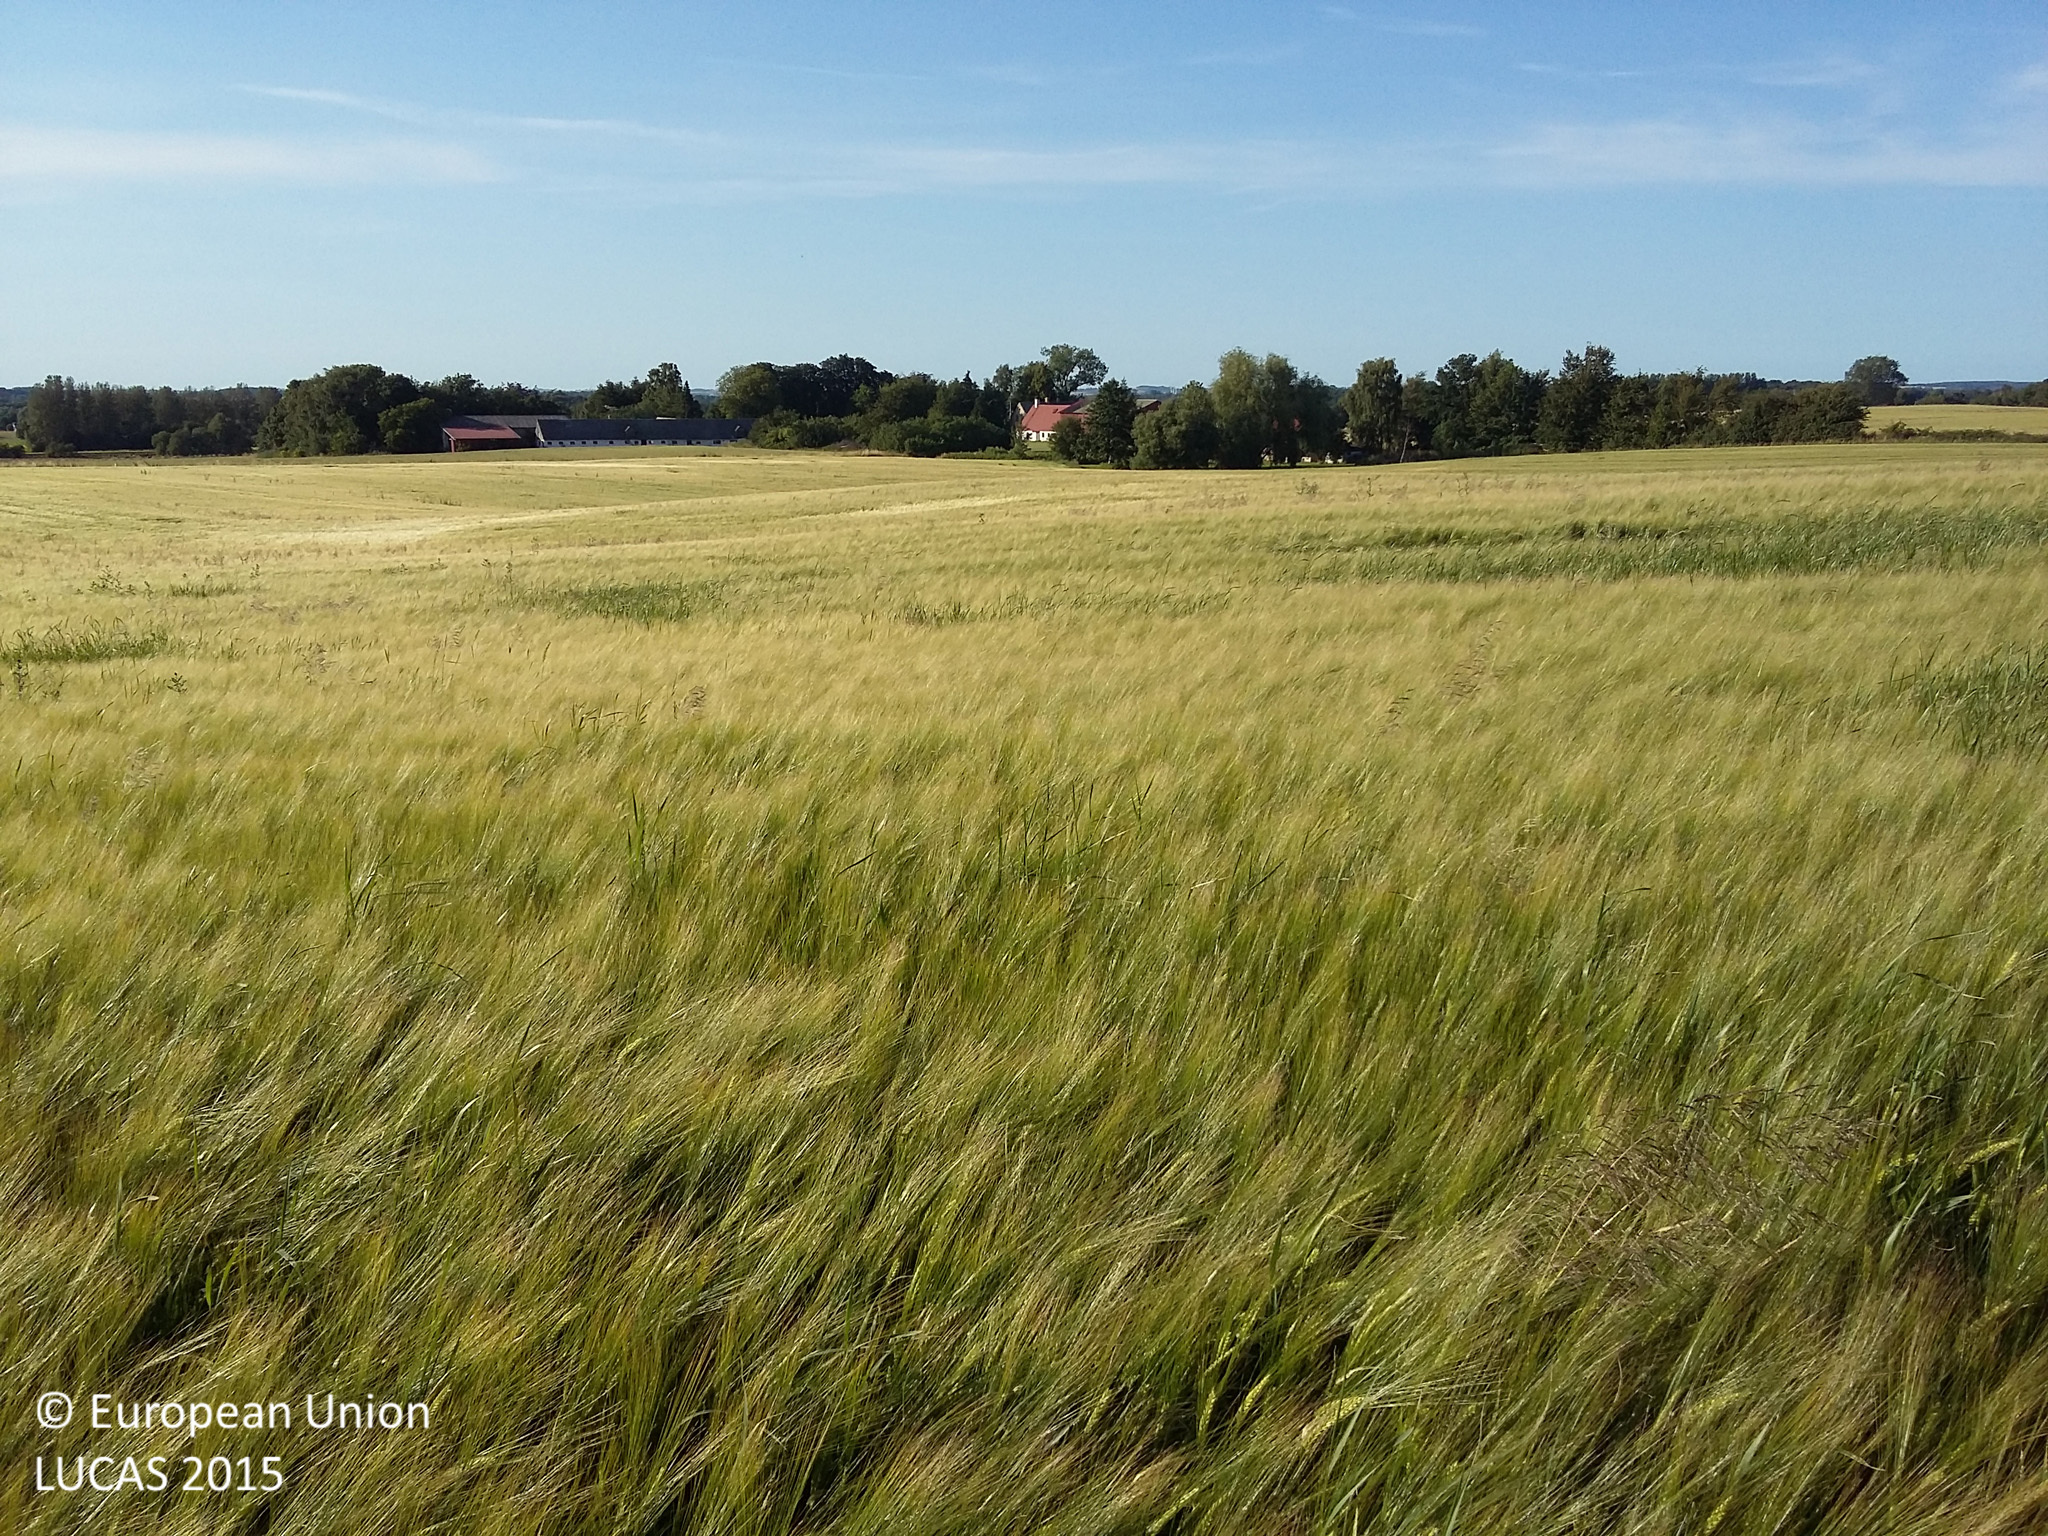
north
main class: Cropland
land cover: Barley
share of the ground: > 75 %
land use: Agriculture (excluding fallow land and kitchen gardens)
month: July
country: DK
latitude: 55.6571
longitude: 11.5403
